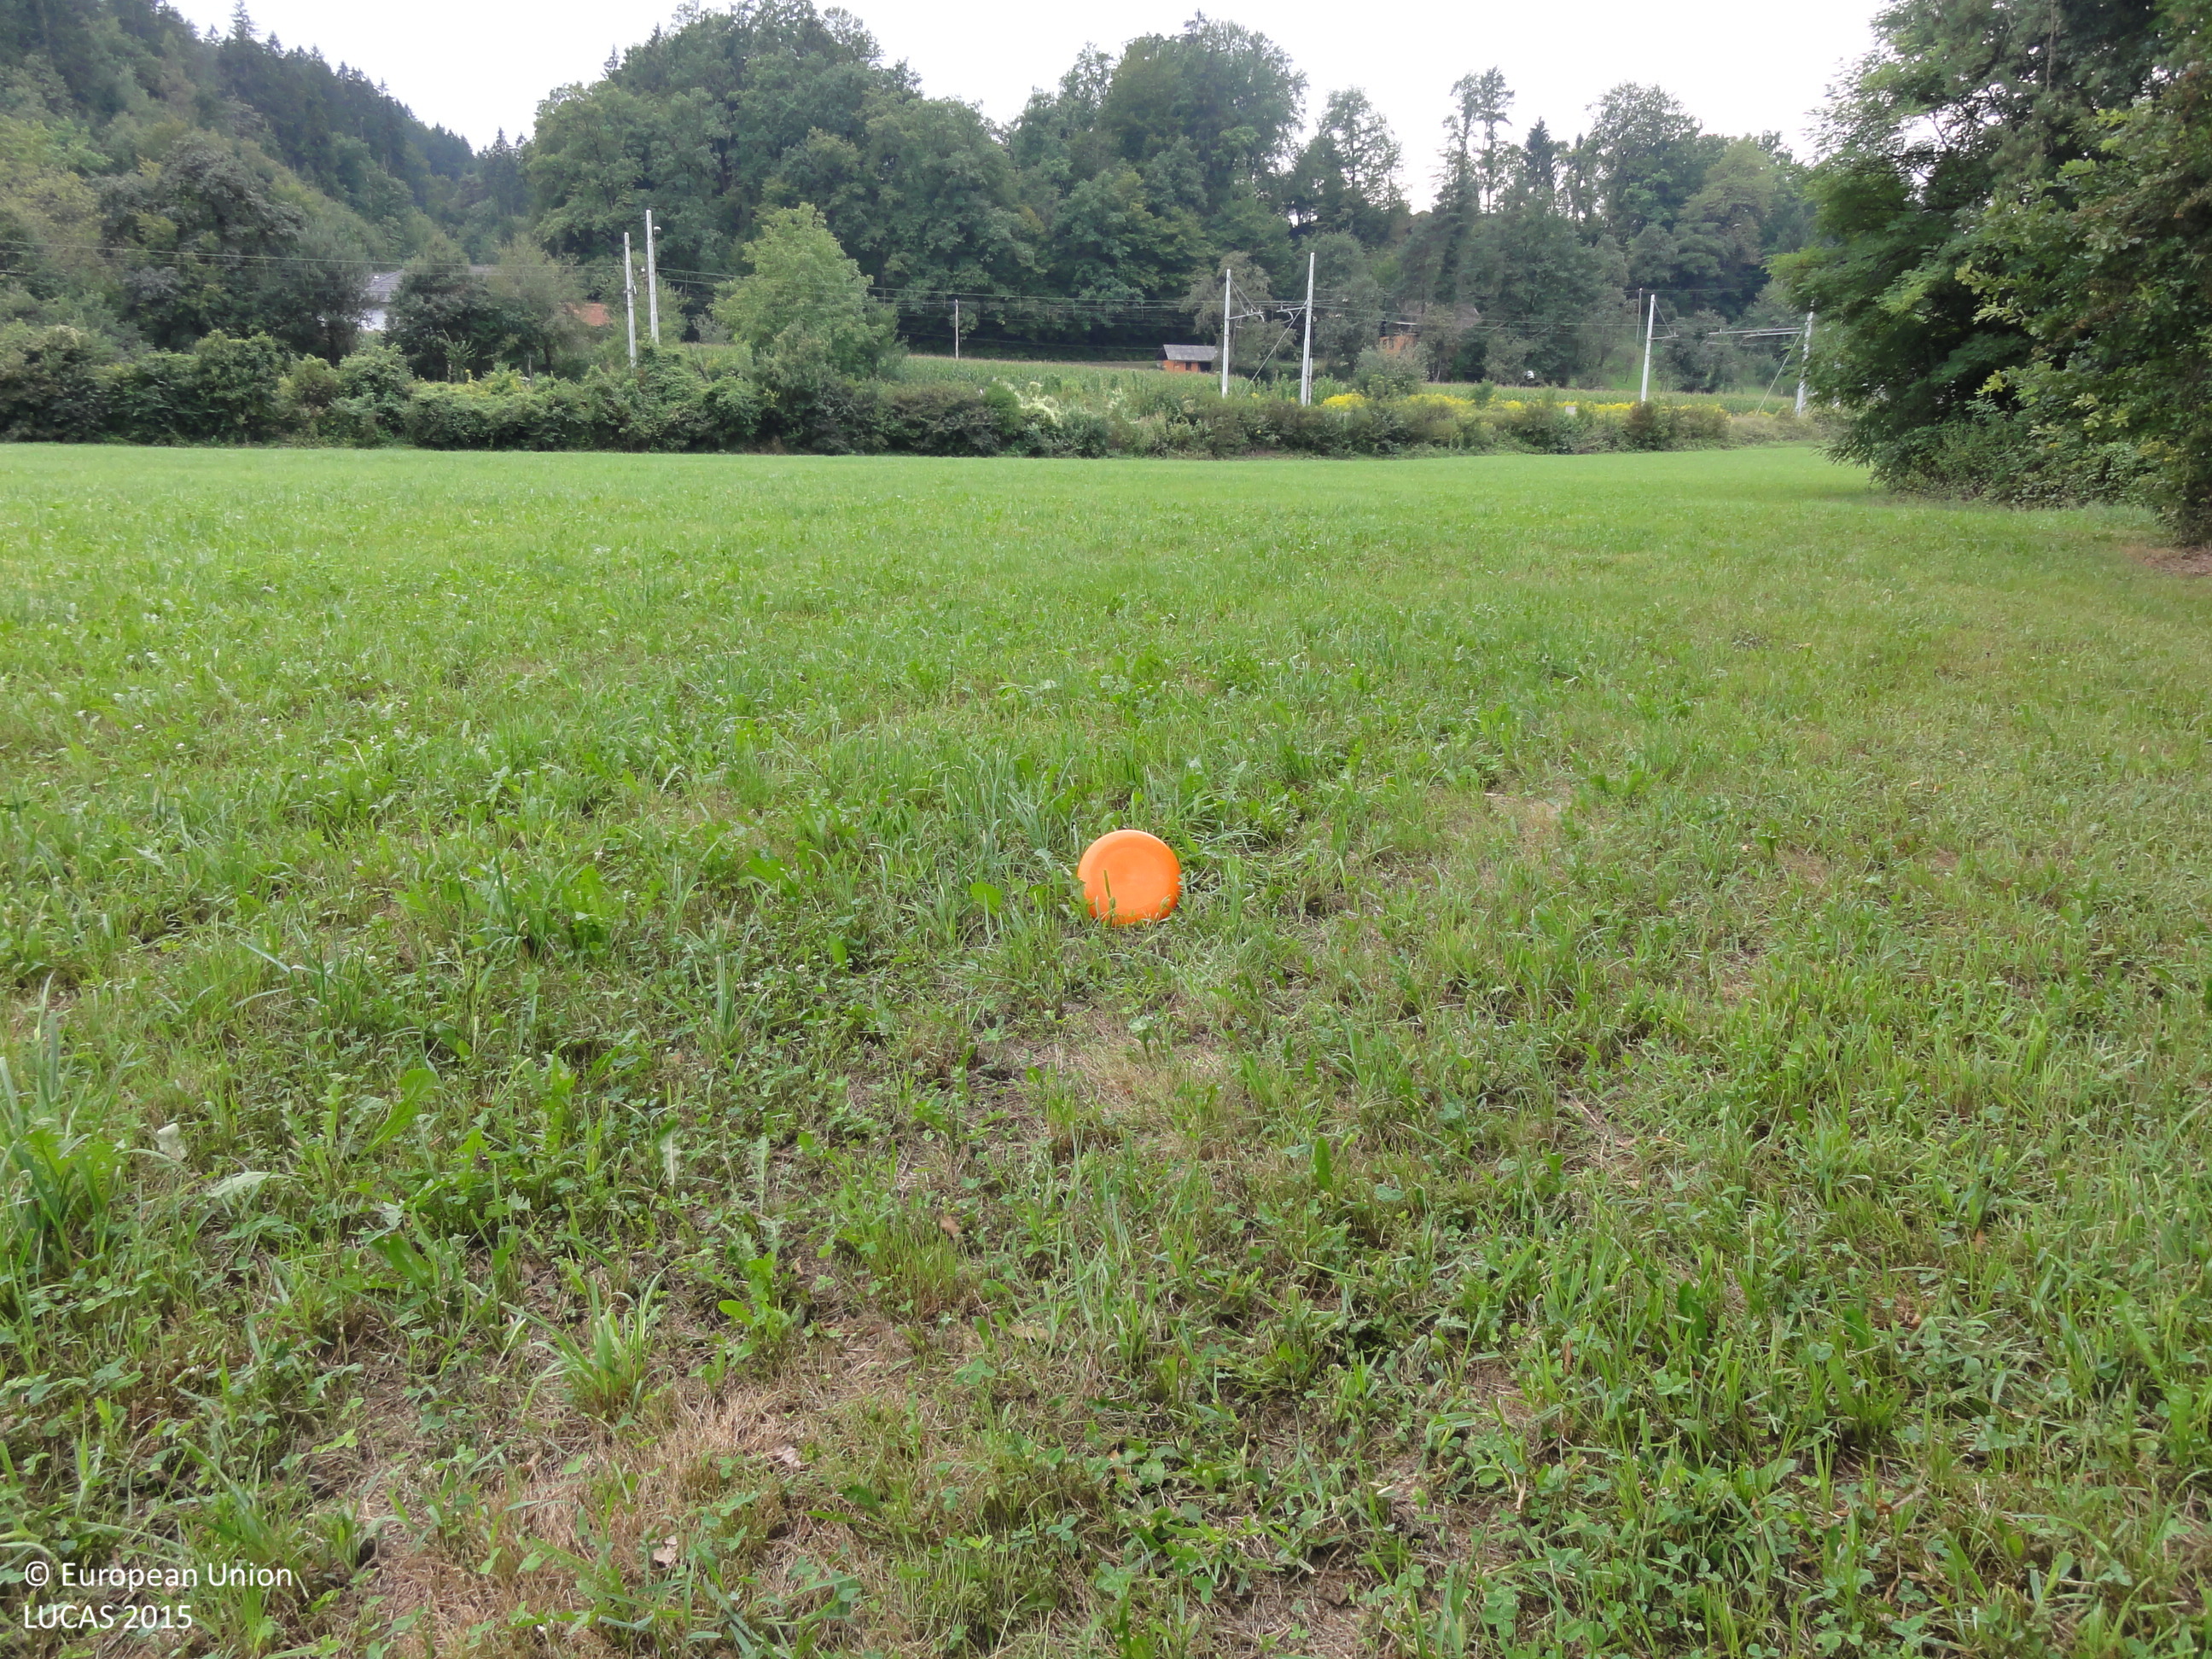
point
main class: Grassland
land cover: Grassland without tree/shrub cover
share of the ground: > 75 %
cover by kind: herbaceous plants 100 %
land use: Agriculture (excluding fallow land and kitchen gardens)
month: August
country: SI
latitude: 46.0993
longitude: 14.7959
